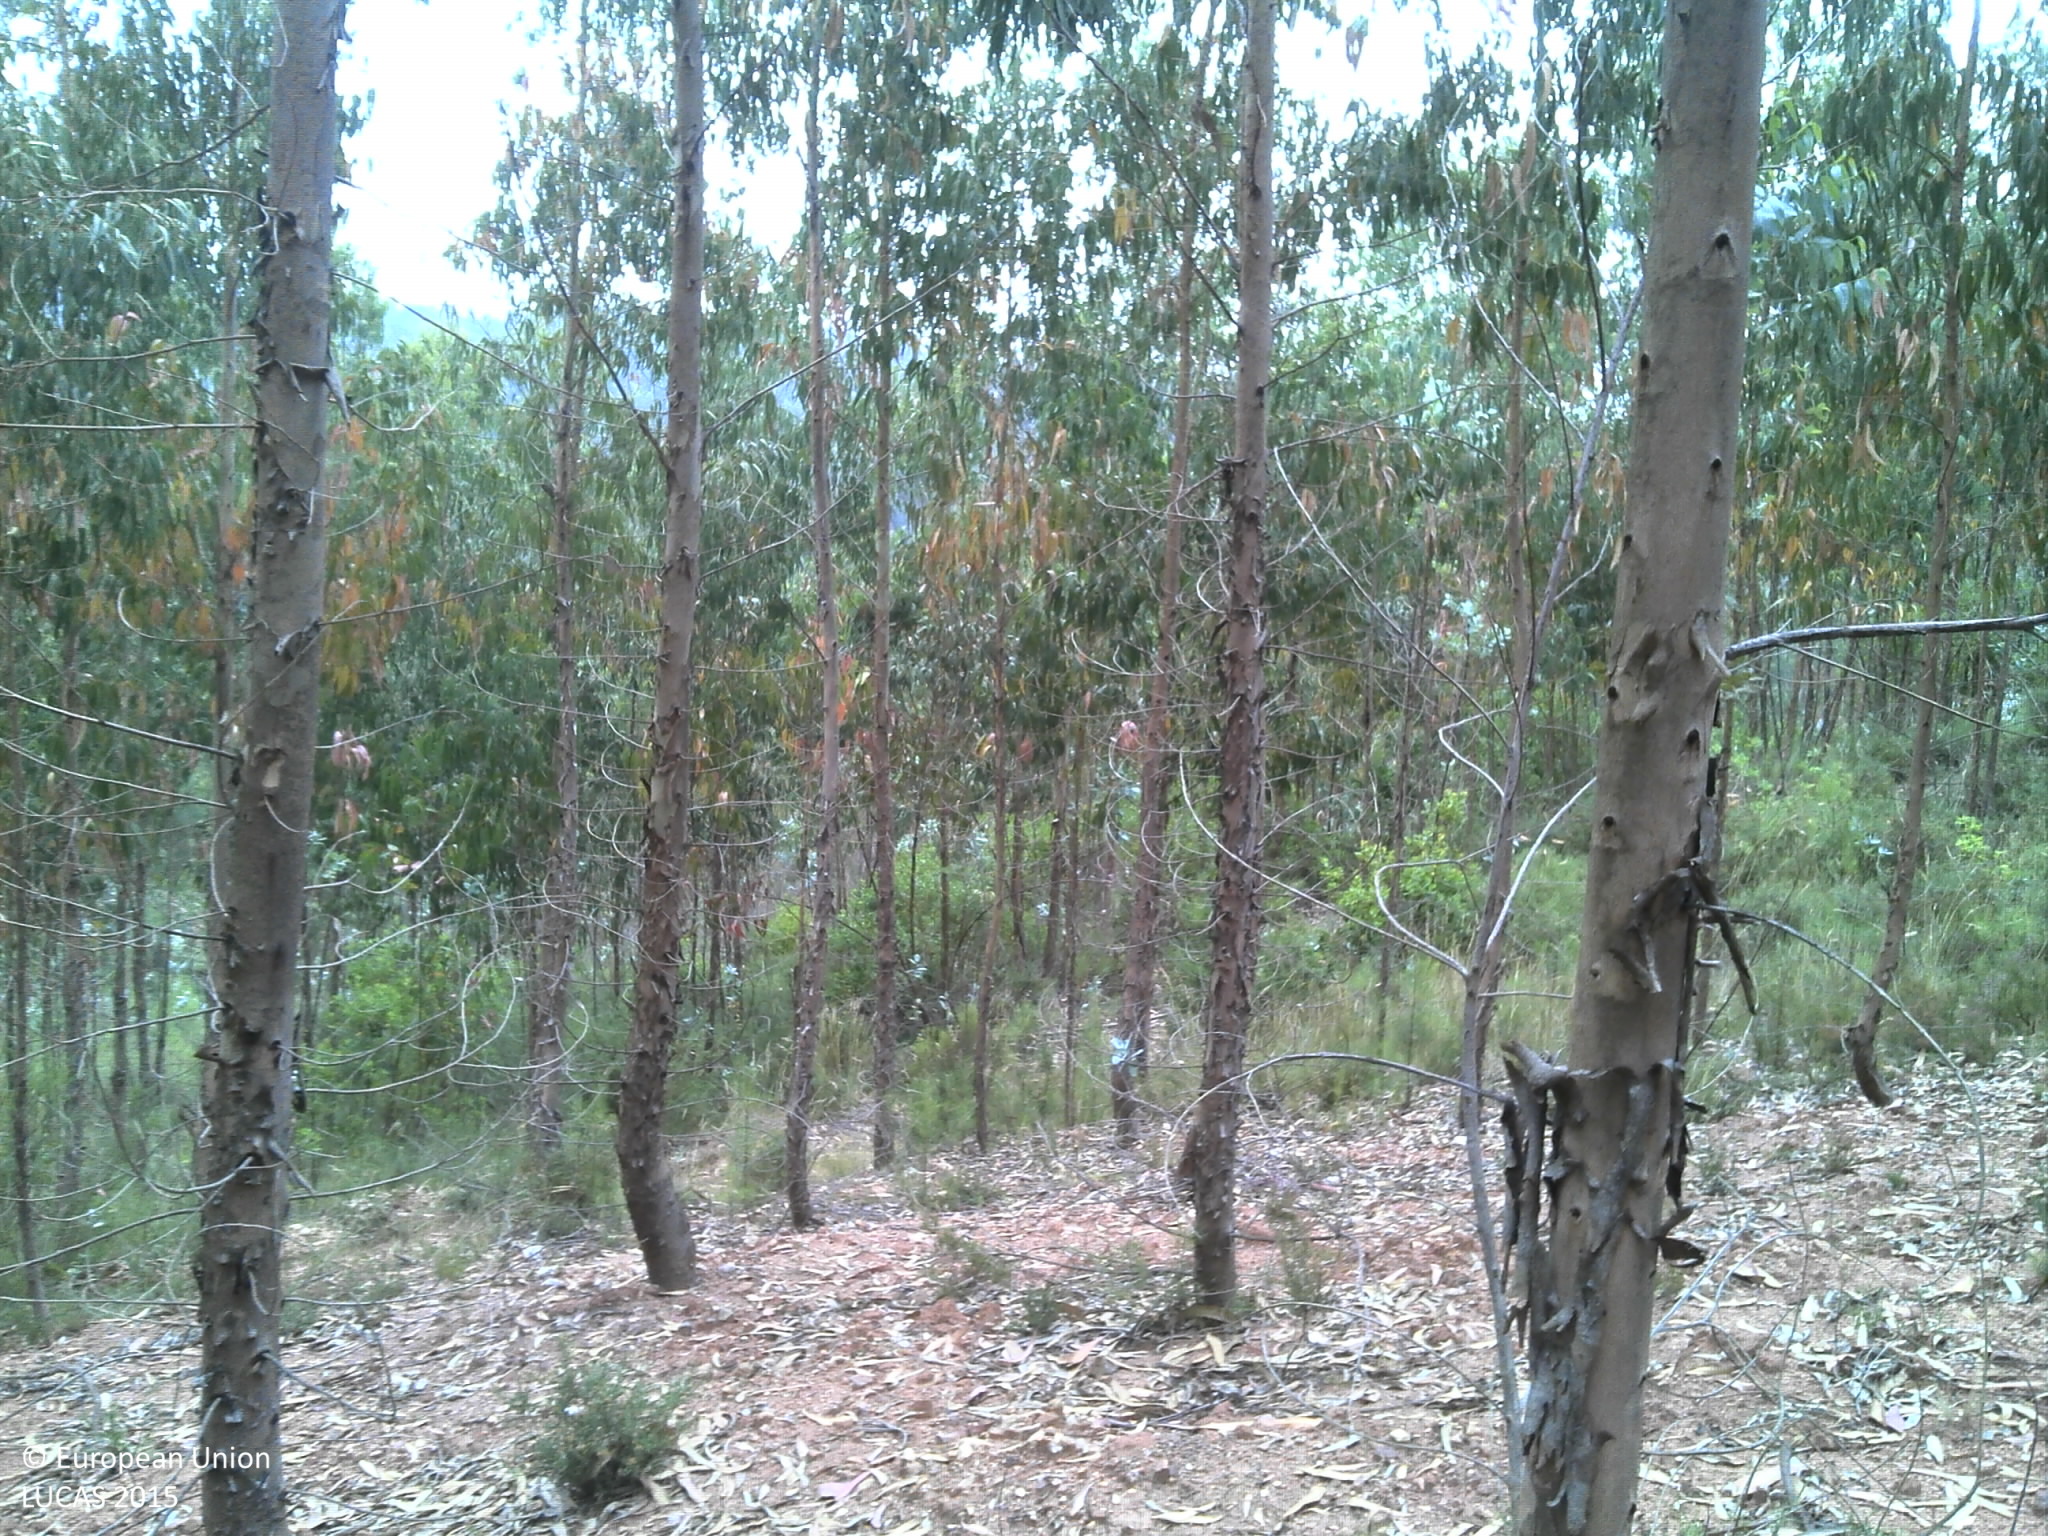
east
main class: Woodland
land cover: Broadleaved woodland
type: exotic forest
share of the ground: 50 - 75 %
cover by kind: broadleaved forest trees 60 %, unconsolidated bare surface 30 %, shrubs 10 %
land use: Forestry
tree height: > 5 m
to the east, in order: Broadleaved woodland; Tracks; Broadleaved woodland; Tracks; Broadleaved woodland; Tracks; Broadleaved woodland; Tracks; Broadleaved woodland
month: June
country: PT
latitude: 40.4171
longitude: -8.3886
